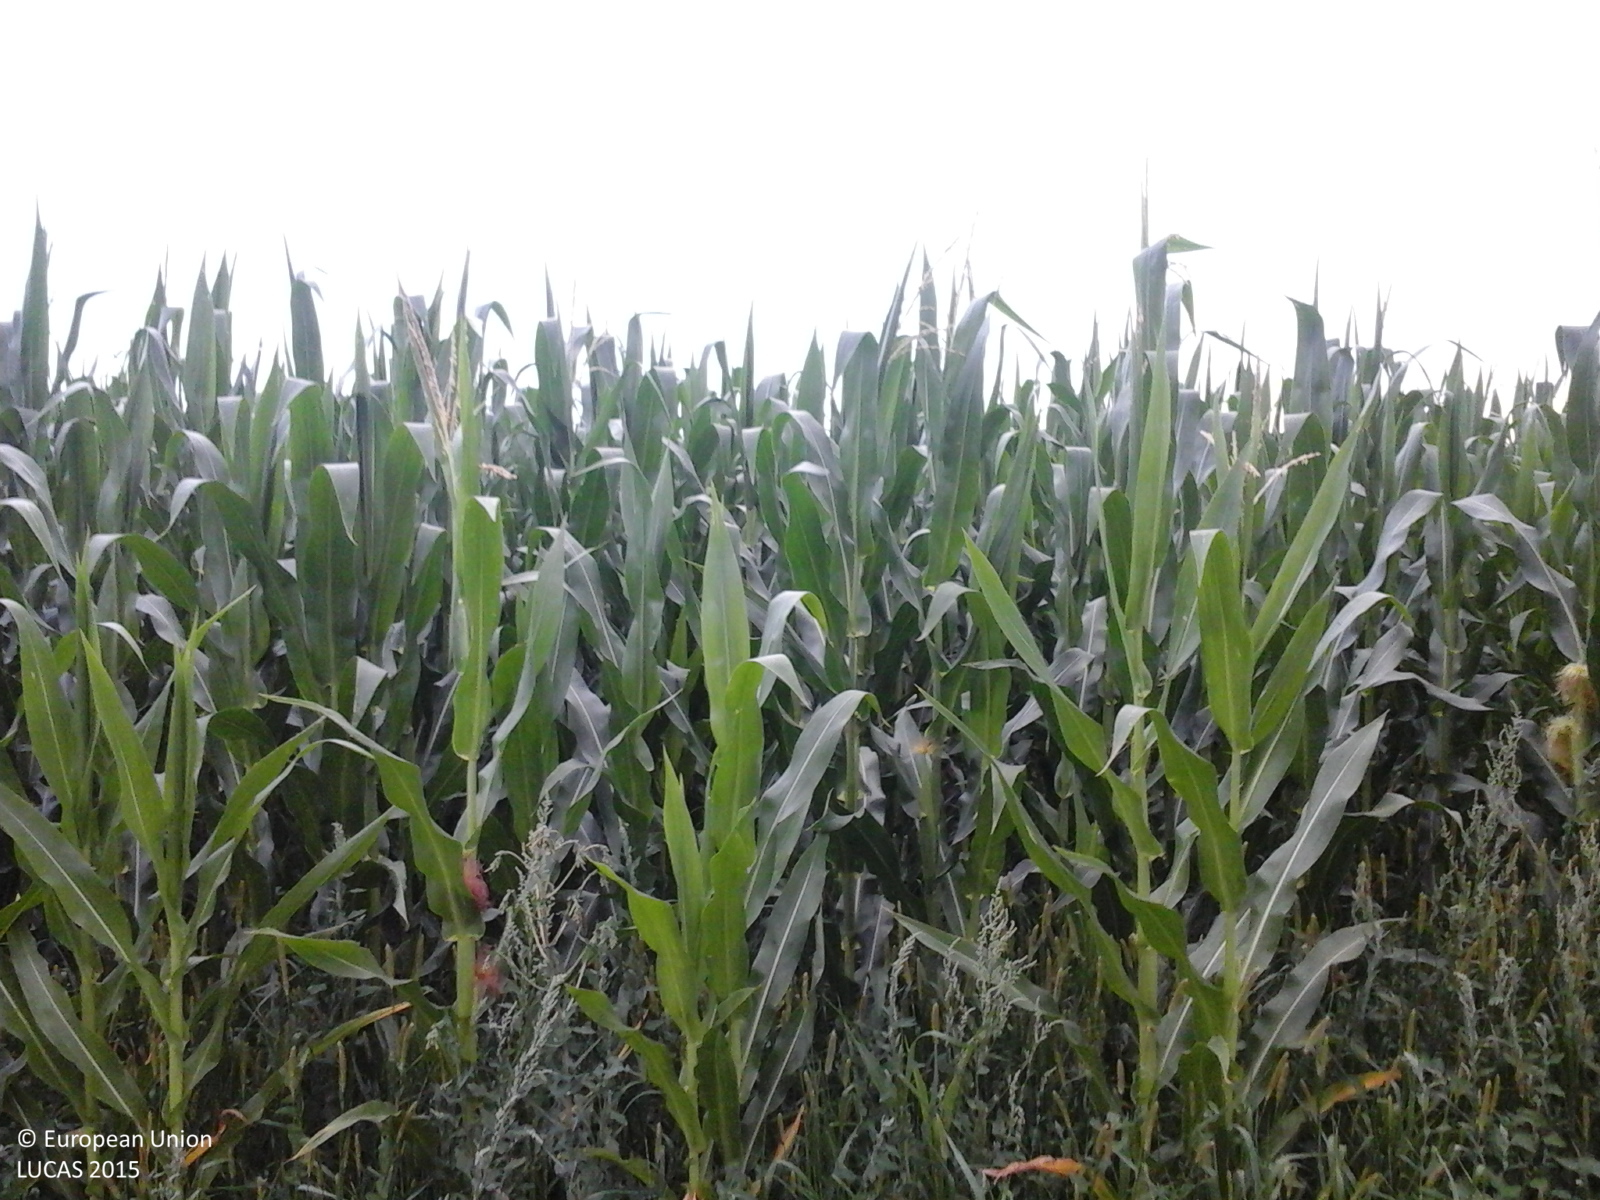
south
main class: Cropland
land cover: Maize
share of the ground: > 75 %
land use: Agriculture (excluding fallow land and kitchen gardens)
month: July
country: RO
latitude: 44.1268
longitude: 24.4004
